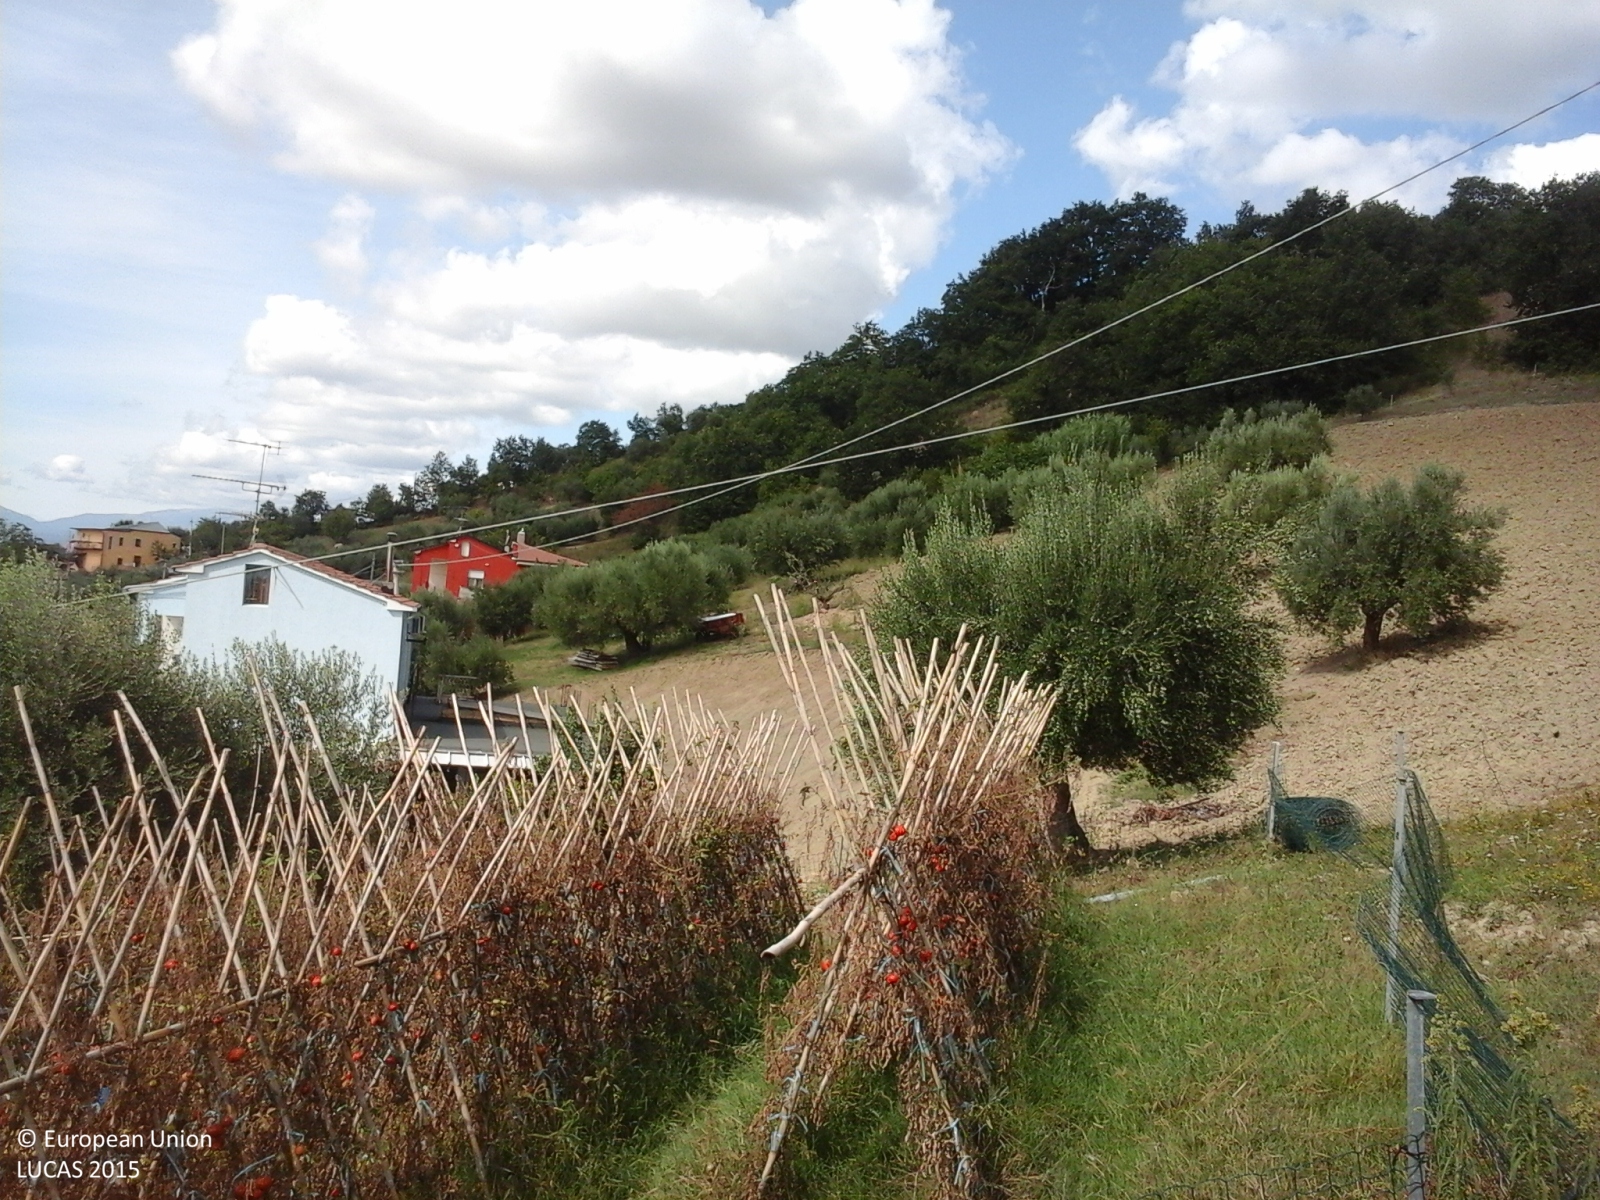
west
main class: Cropland
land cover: Olive groves
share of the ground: 10 - 25 %
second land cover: Tomatoes
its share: 50 - 75 %
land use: Agriculture (excluding fallow land and kitchen gardens)
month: September
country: IT
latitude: 42.6368
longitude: 13.8059
